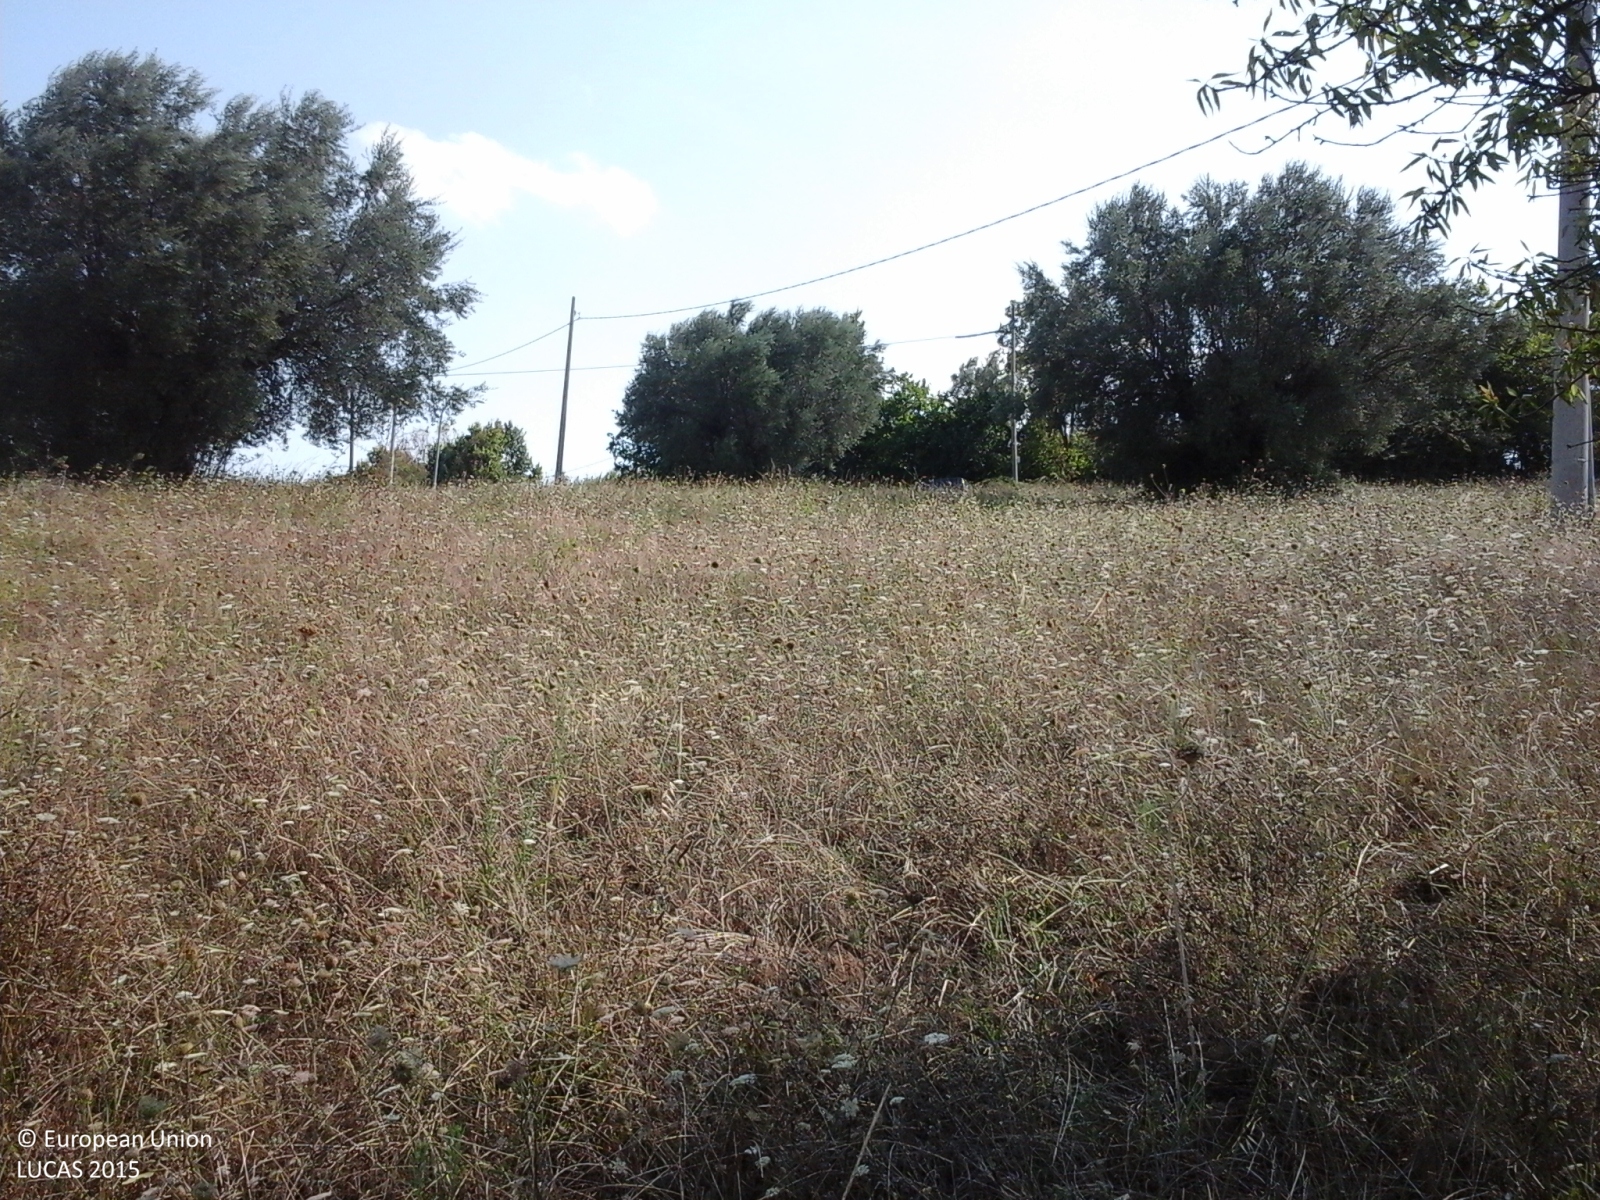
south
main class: Cropland
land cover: Nuts trees
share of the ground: < 10 %
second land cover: Spontaneously vegetated surfaces
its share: > 75 %
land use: Agriculture (excluding fallow land and kitchen gardens)
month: August
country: IT
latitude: 42.6710
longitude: 13.8568
